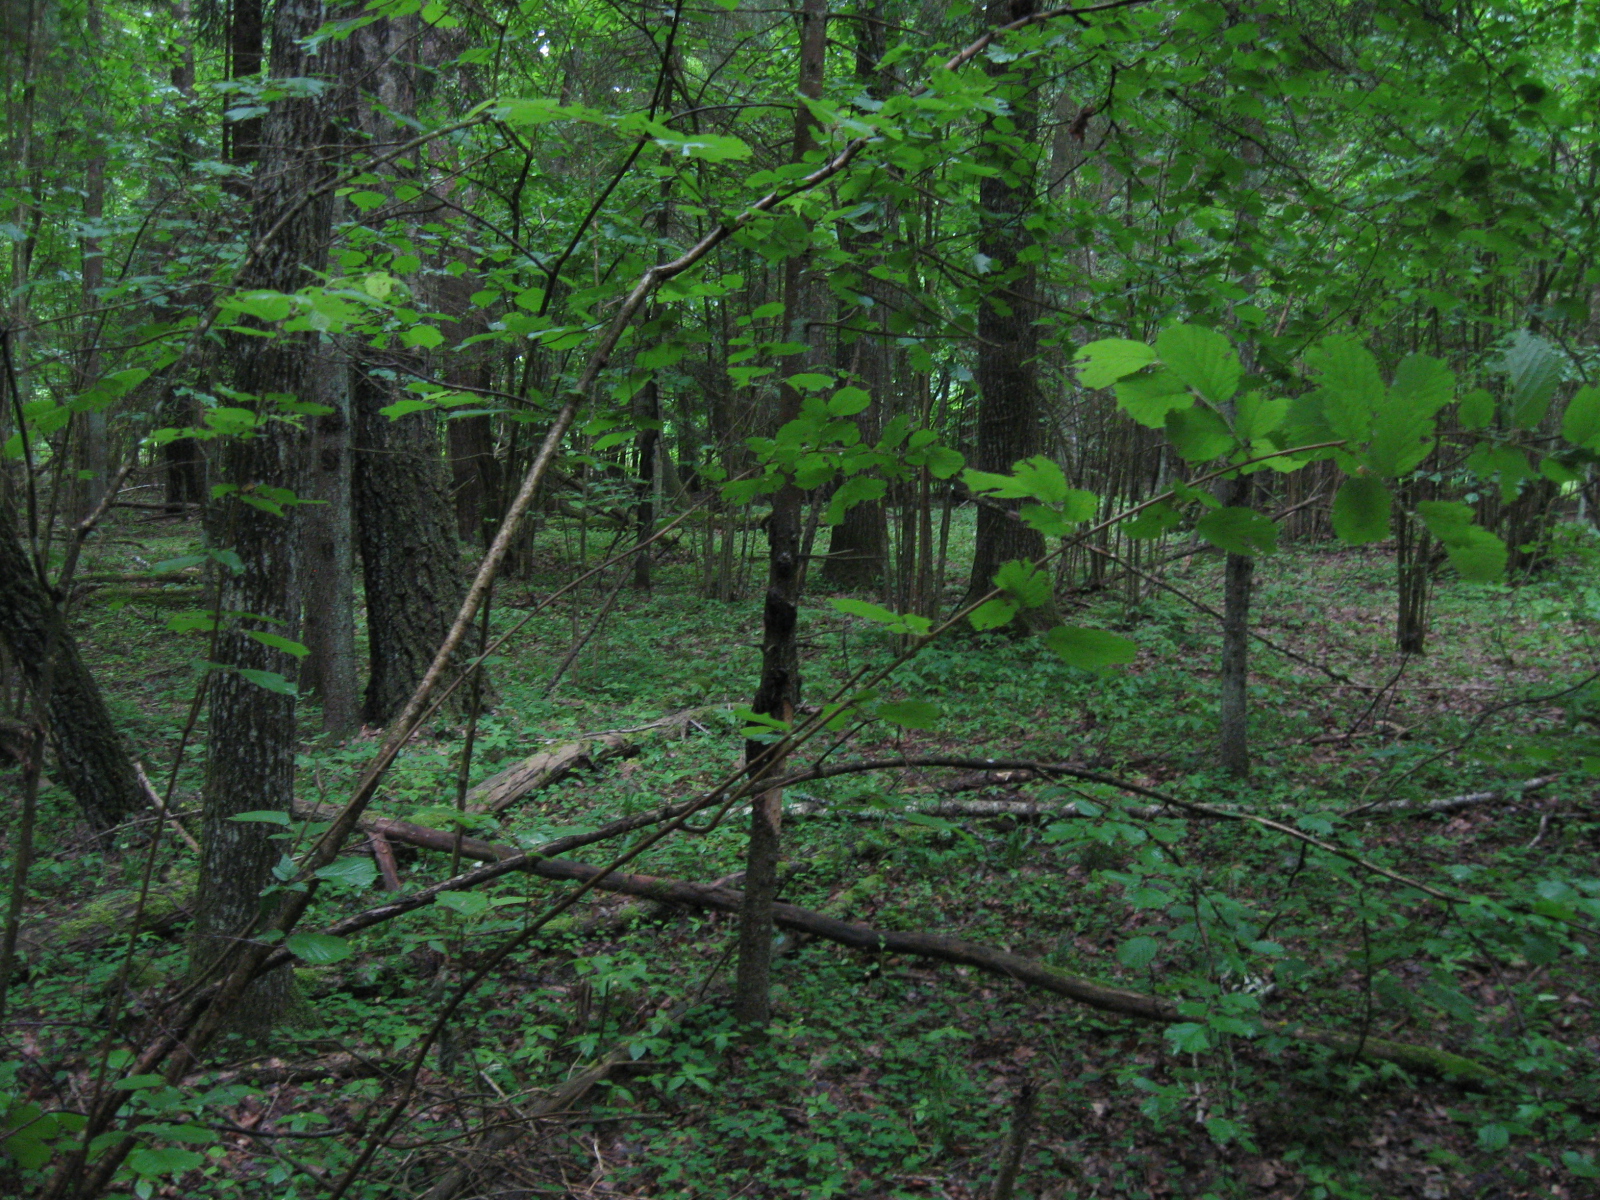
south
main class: Woodland
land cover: Spruce dominated mixed woodland
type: hemiboreal forest and nemoral coniferous forest and mixed broadleaved-coniferous forest
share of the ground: > 75 %
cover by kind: coniferous forest trees 60 %, broadleaved forest trees 35 %, herbaceous plants 5 %
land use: Forestry
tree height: > 5 m
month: June
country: LT
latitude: 54.8235
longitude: 24.5314
